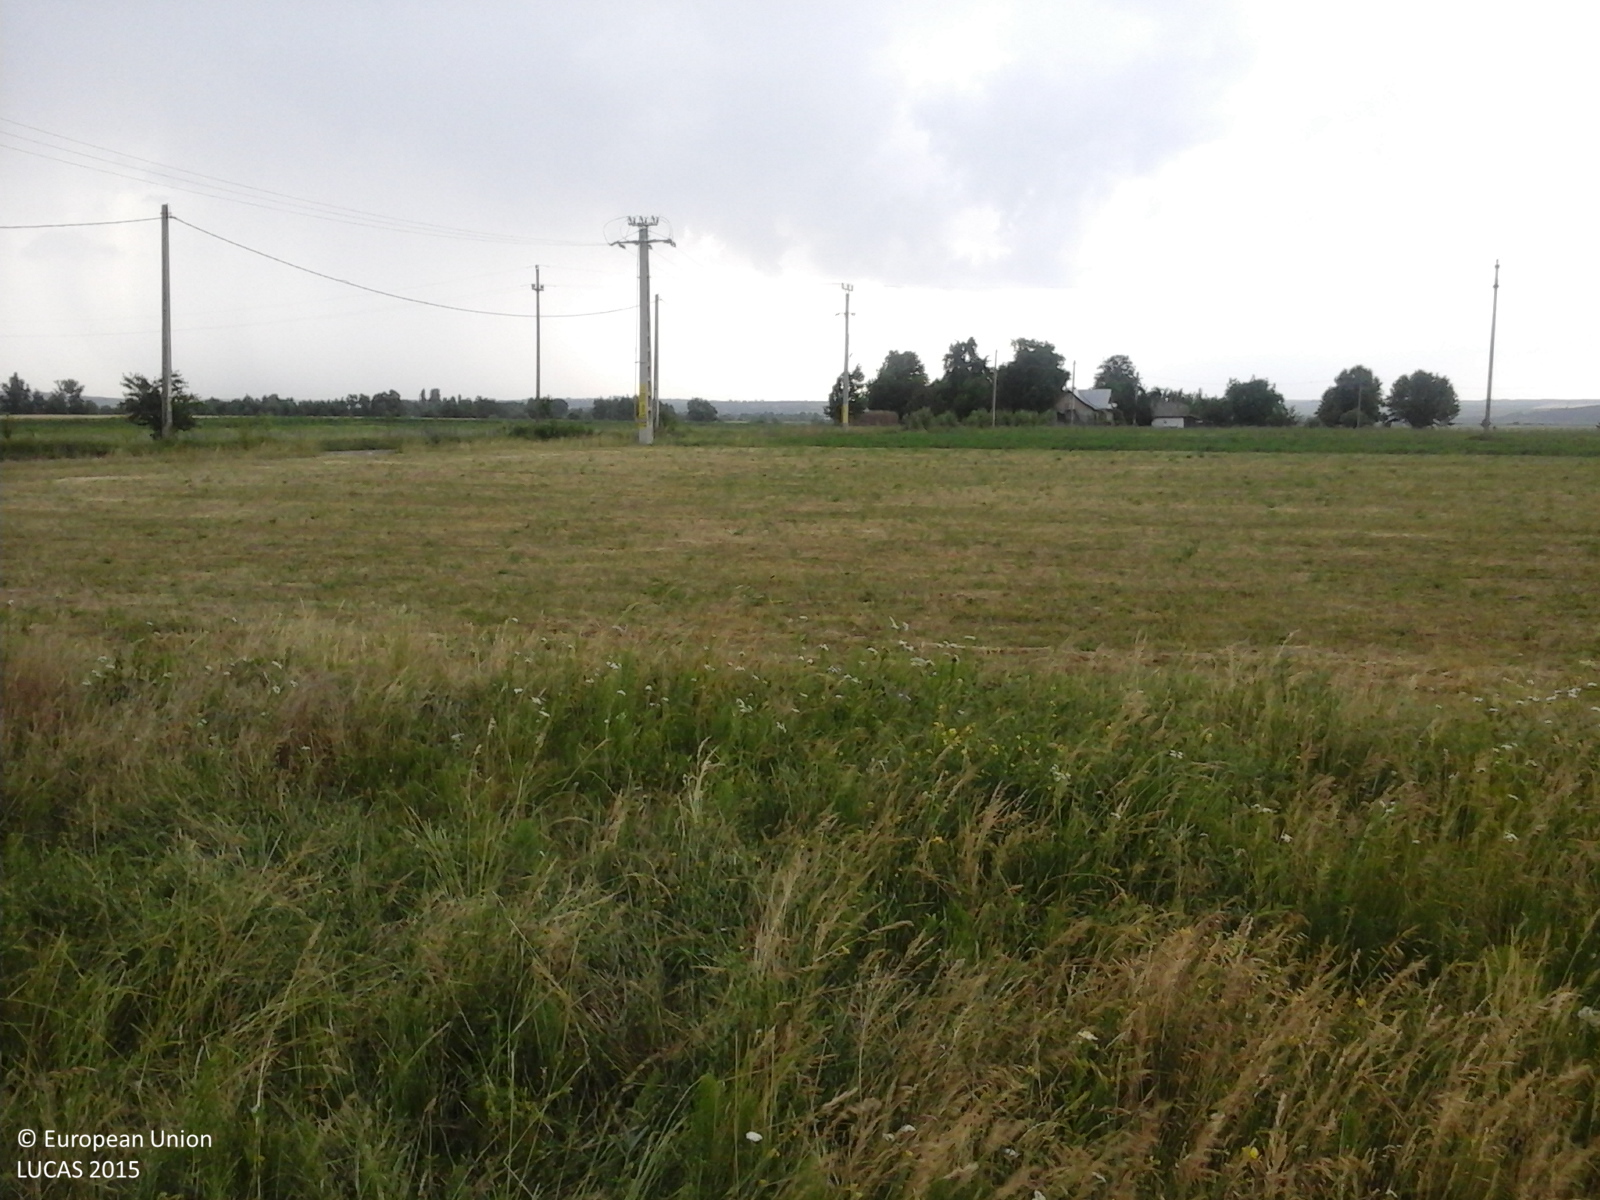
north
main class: Grassland
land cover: Grassland without tree/shrub cover
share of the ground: > 75 %
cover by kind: herbaceous plants 100 %
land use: Agriculture (excluding fallow land and kitchen gardens)
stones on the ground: < 10 %
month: June
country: RO
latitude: 47.2723
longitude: 26.4367
